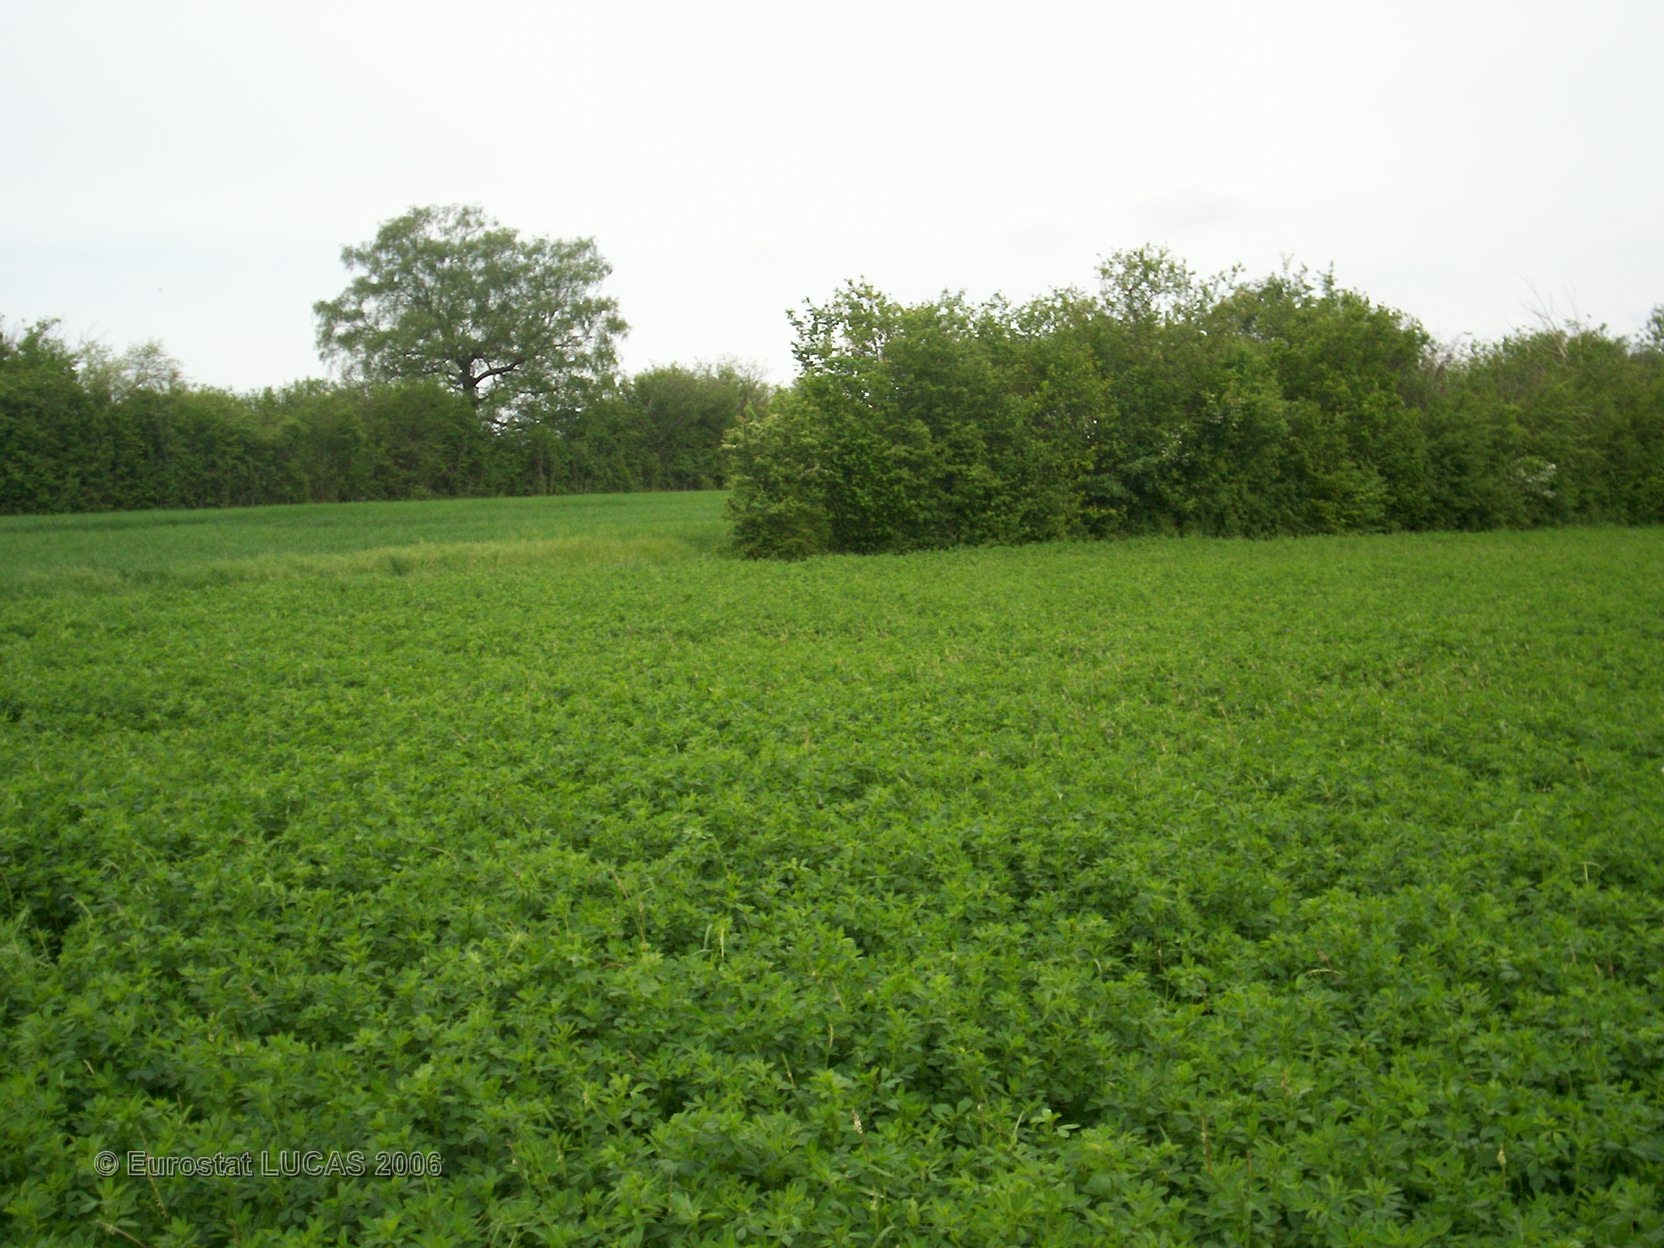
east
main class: Cropland
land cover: Lucerne
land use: Agriculture (excluding fallow land and kitchen gardens)
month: May
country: FR
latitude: 47.3190
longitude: 4.6682
